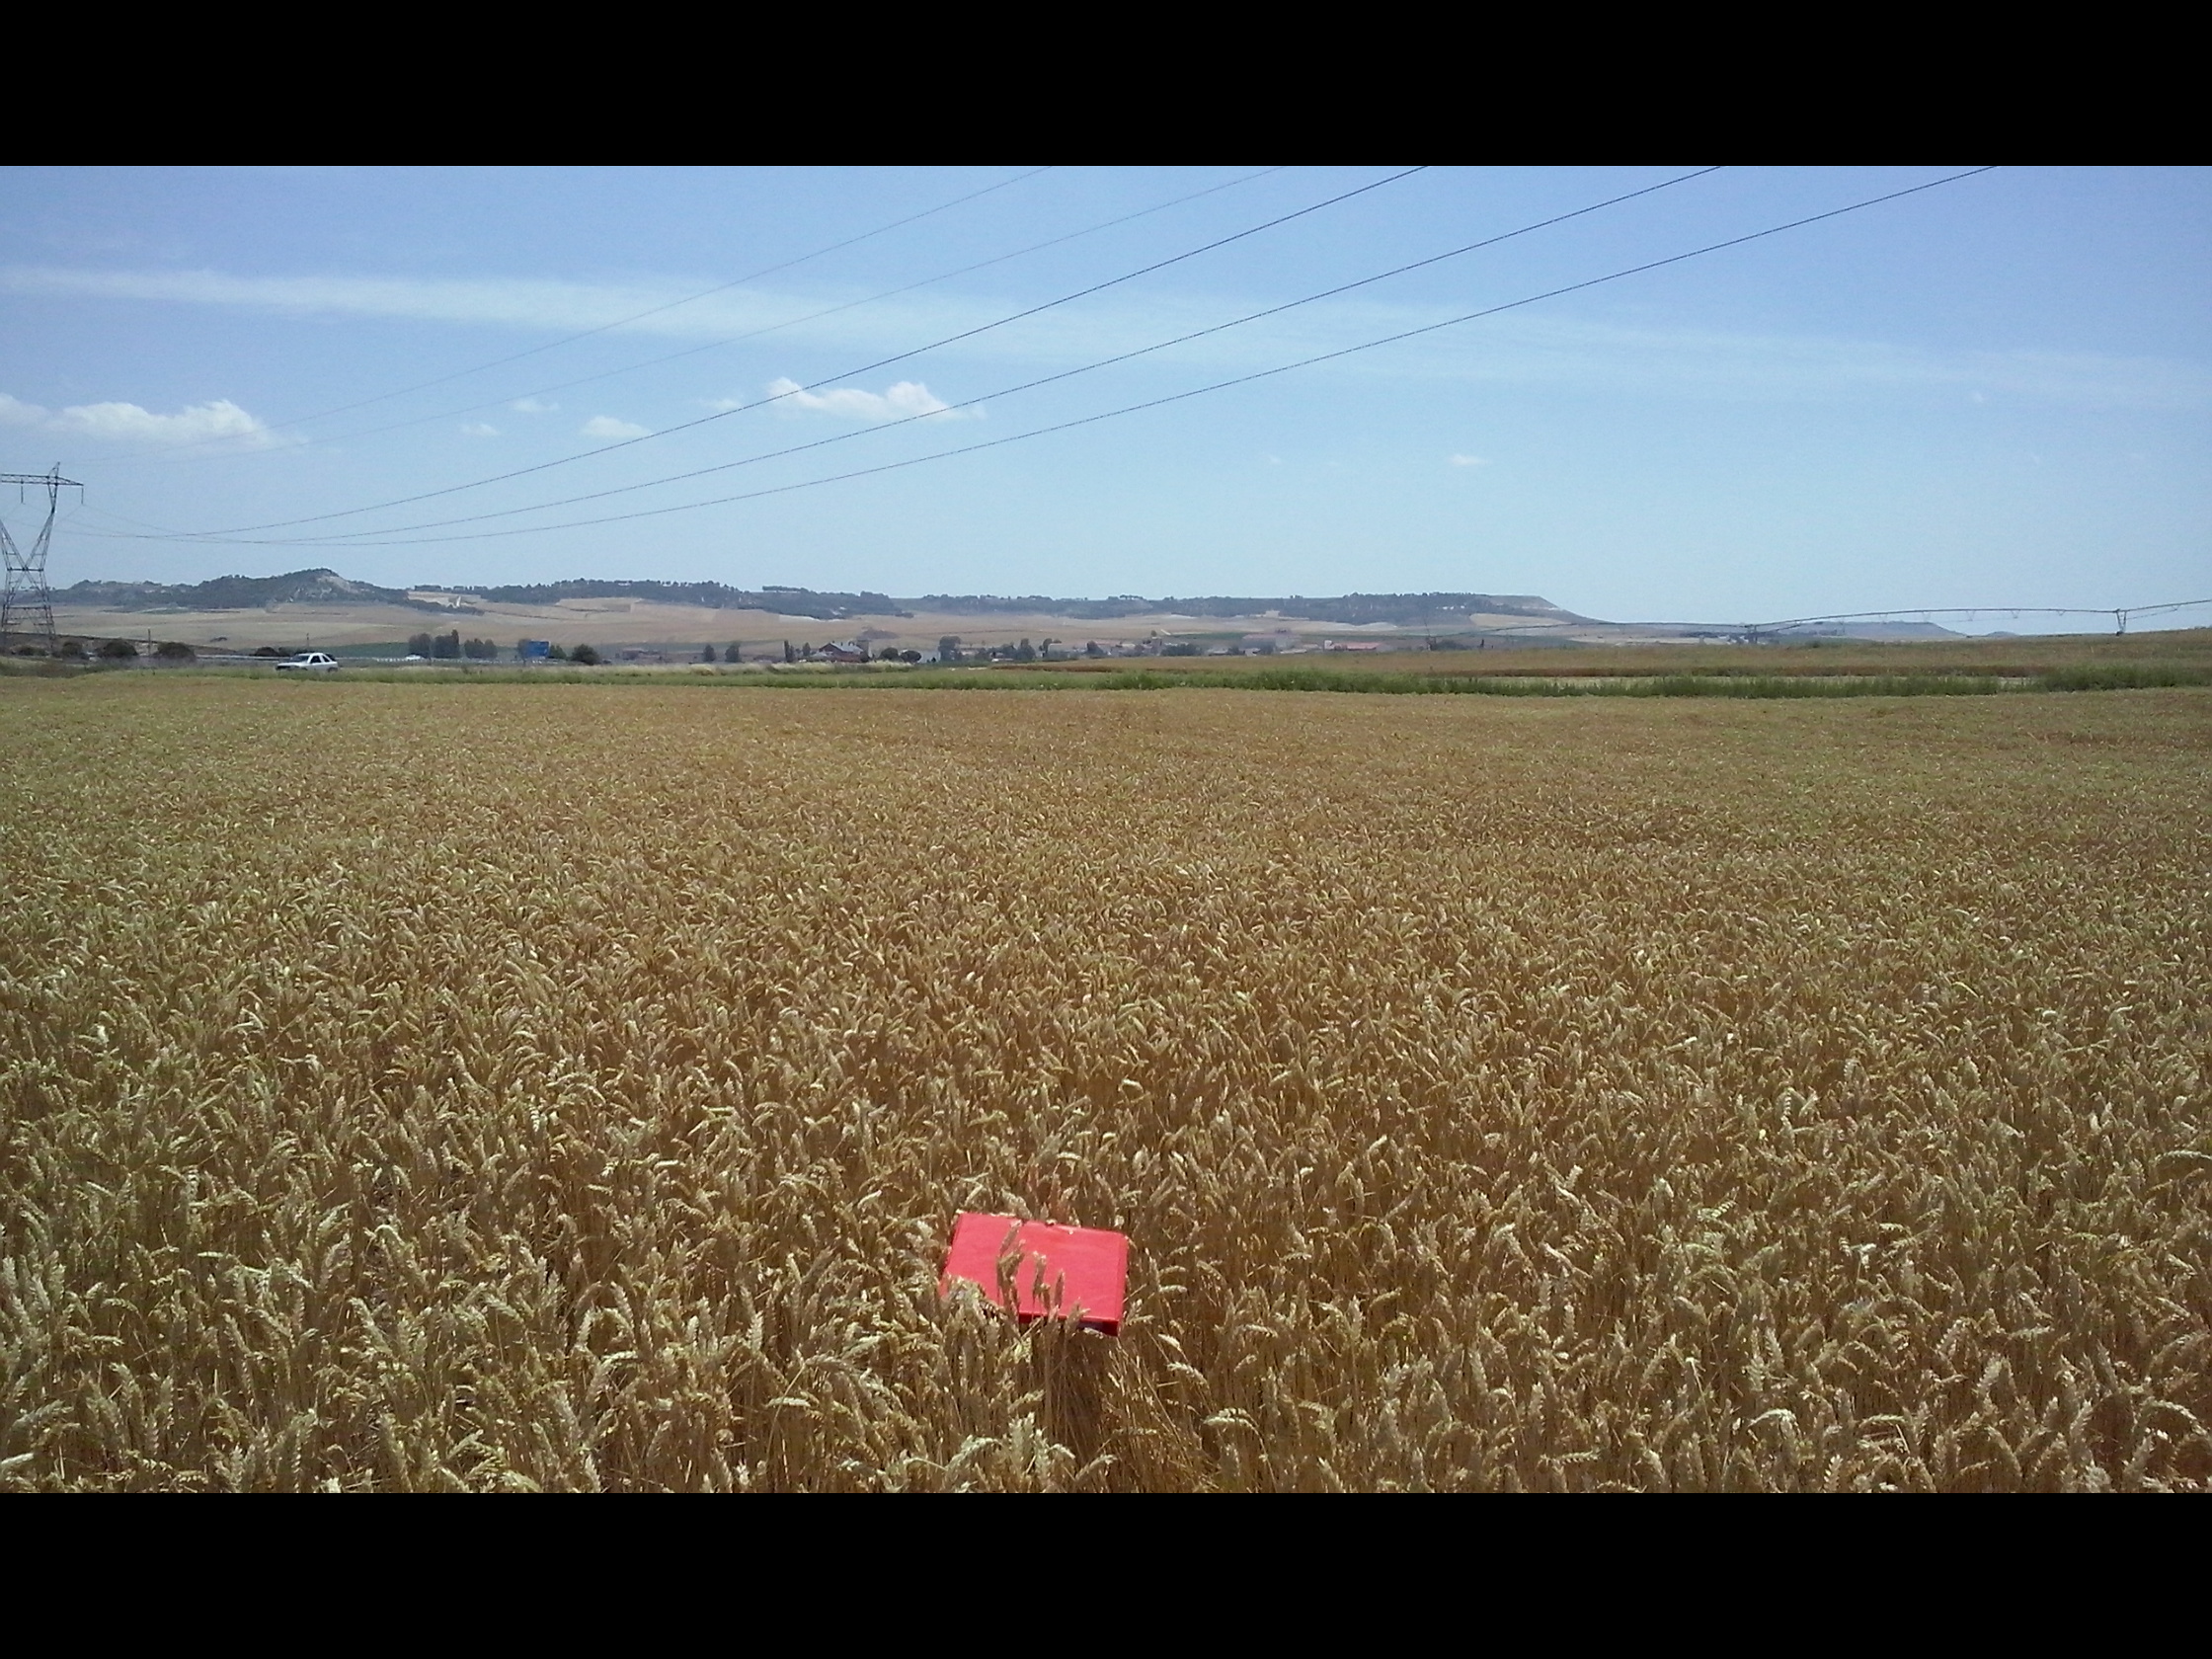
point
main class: Cropland
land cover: Common wheat
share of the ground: > 75 %
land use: Agriculture (excluding fallow land and kitchen gardens)
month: July
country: ES
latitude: 41.6011
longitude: -5.1335
